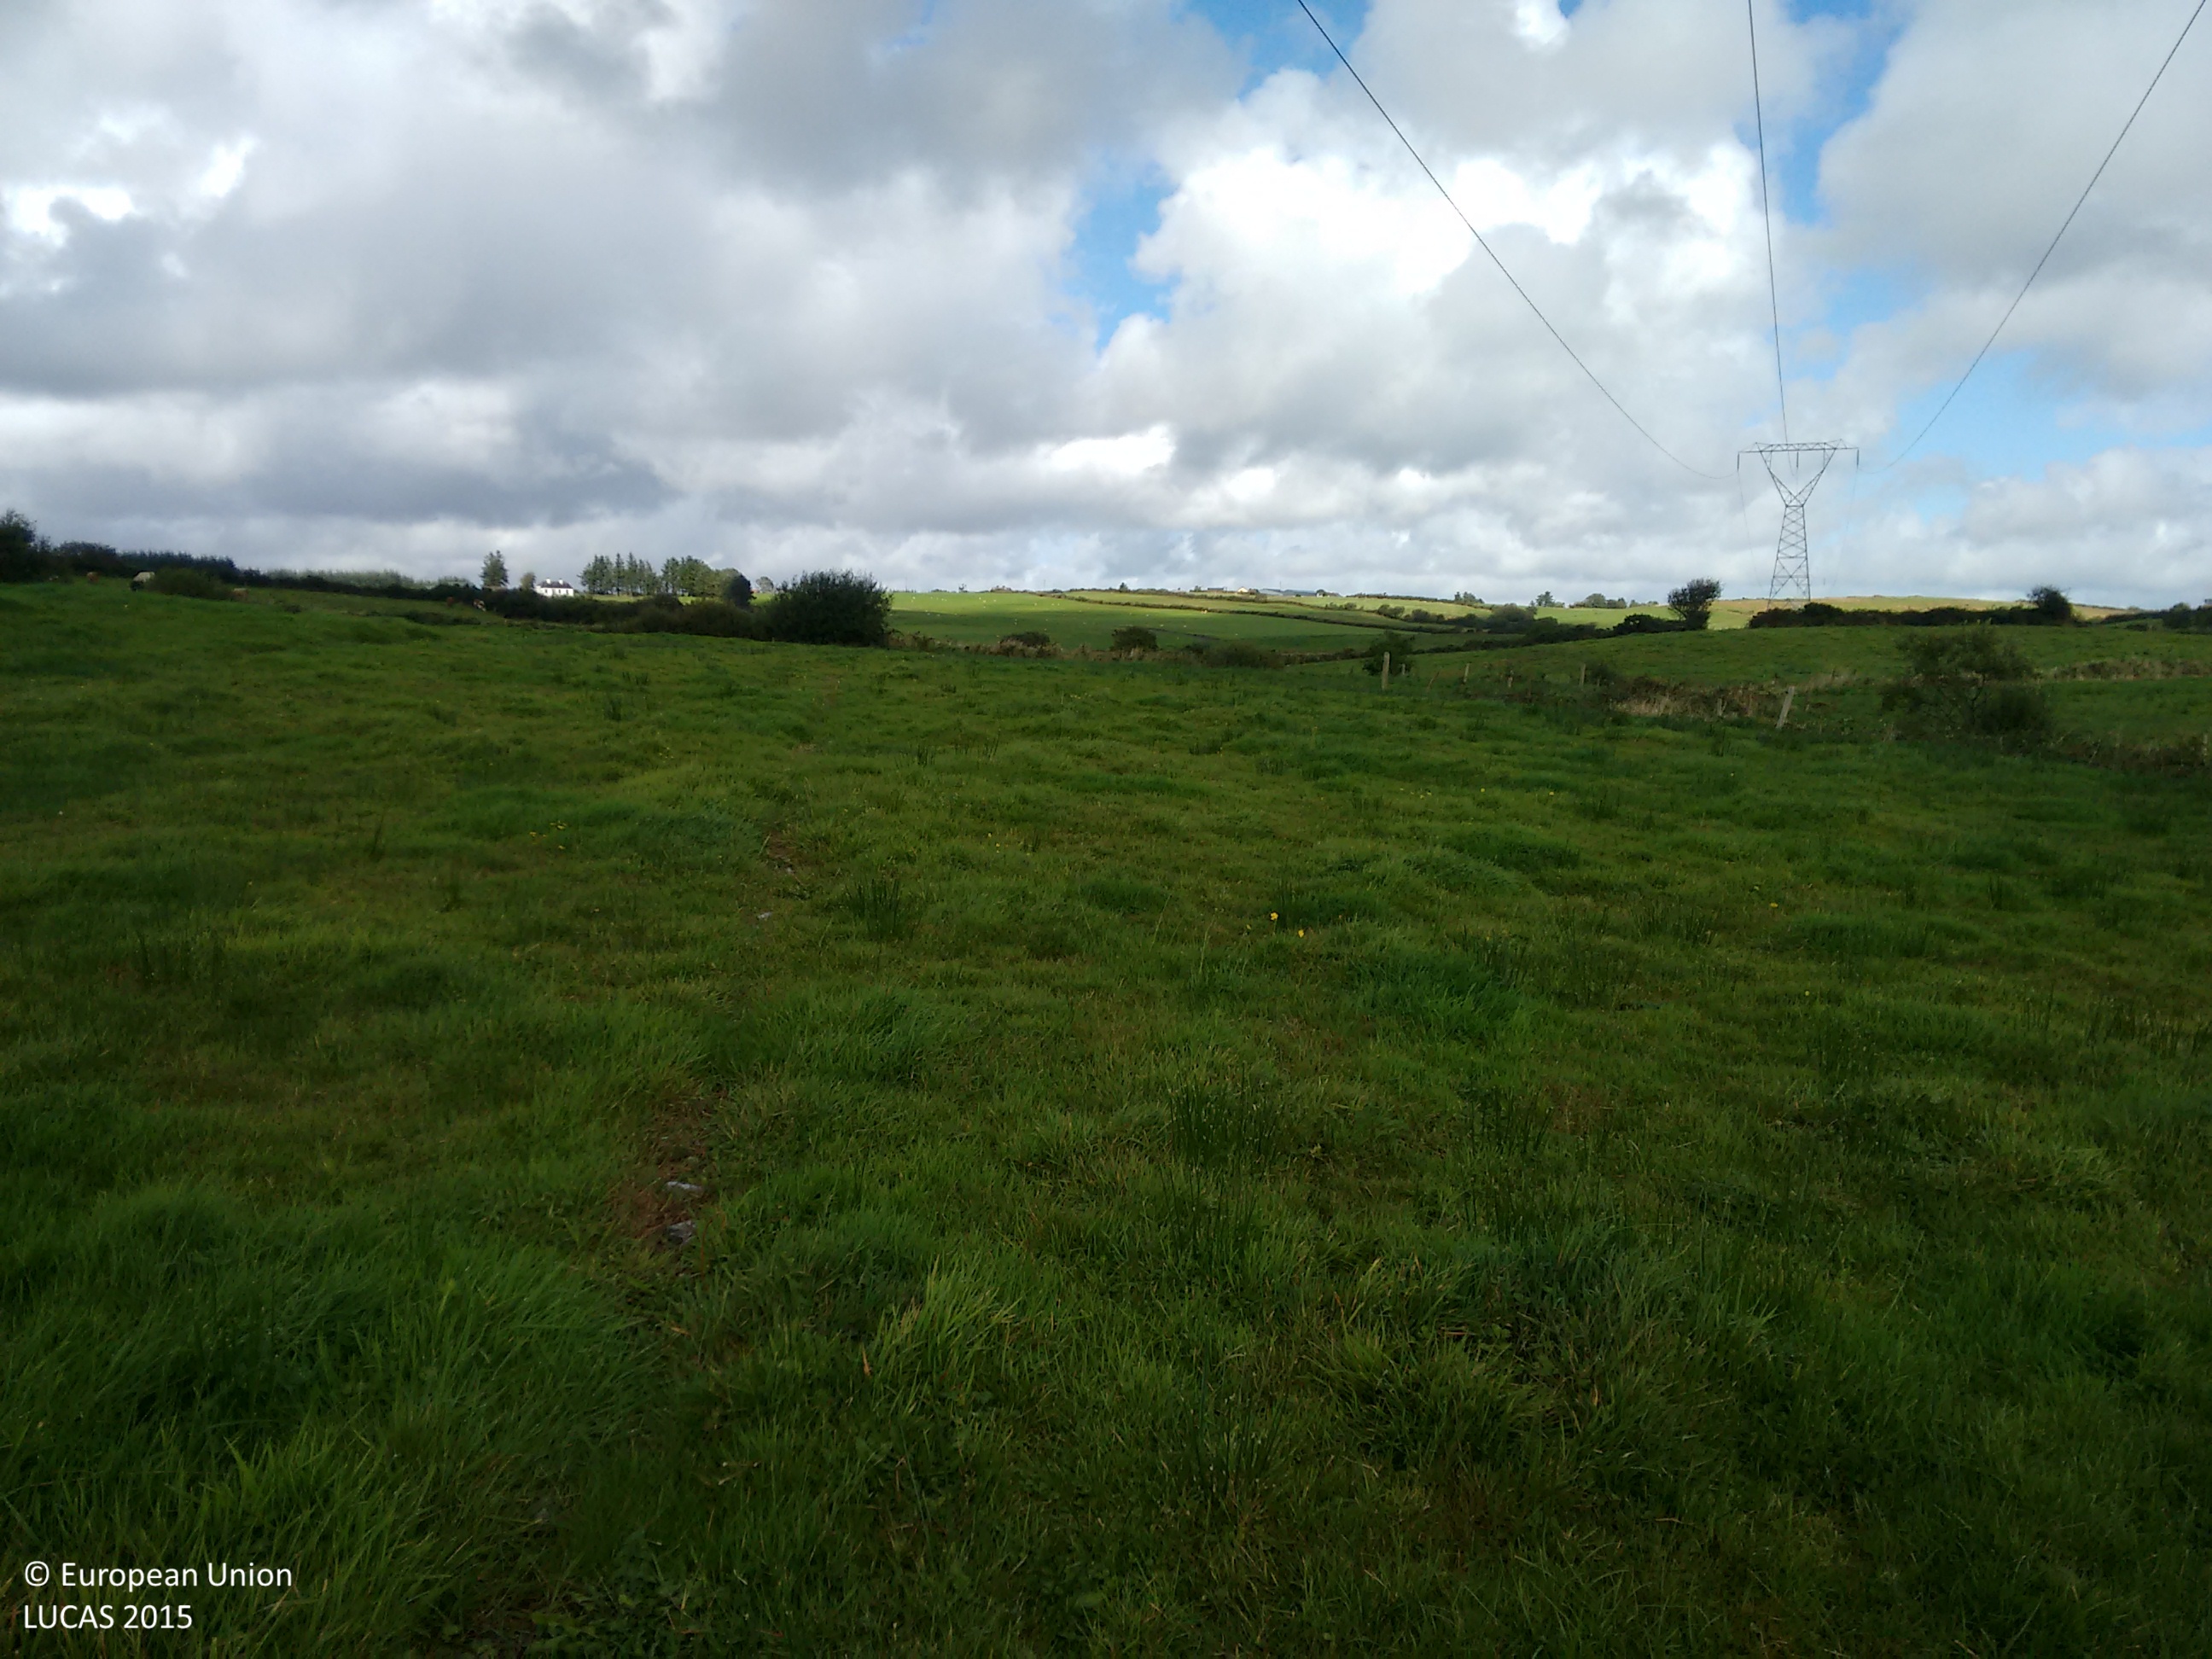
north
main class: Grassland
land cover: Grassland without tree/shrub cover
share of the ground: > 75 %
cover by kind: herbaceous plants 95 %, unconsolidated bare surface 5 %
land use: Agriculture (excluding fallow land and kitchen gardens)
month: September
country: IE
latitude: 52.7162
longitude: -9.1837
